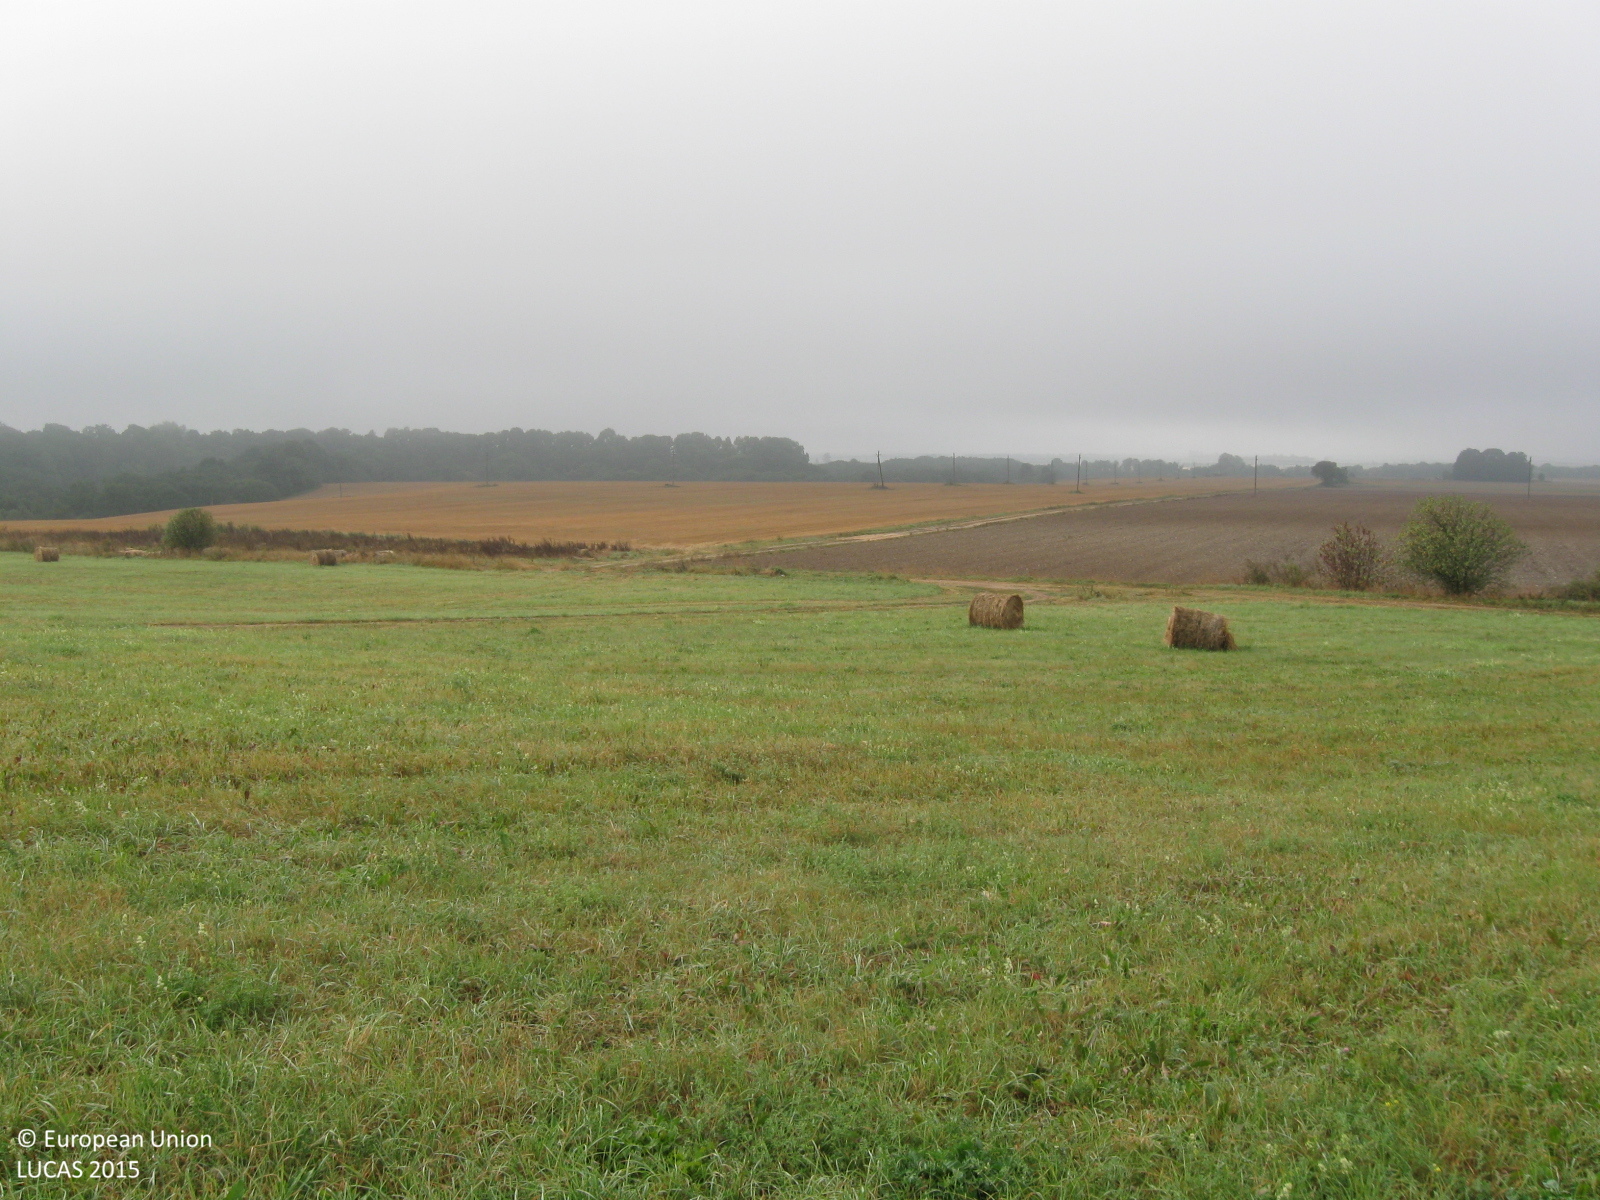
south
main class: Grassland
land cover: Grassland without tree/shrub cover
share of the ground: > 75 %
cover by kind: herbaceous plants 100 %
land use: Agriculture (excluding fallow land and kitchen gardens)
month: August
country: LT
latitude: 55.3402
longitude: 23.1757
